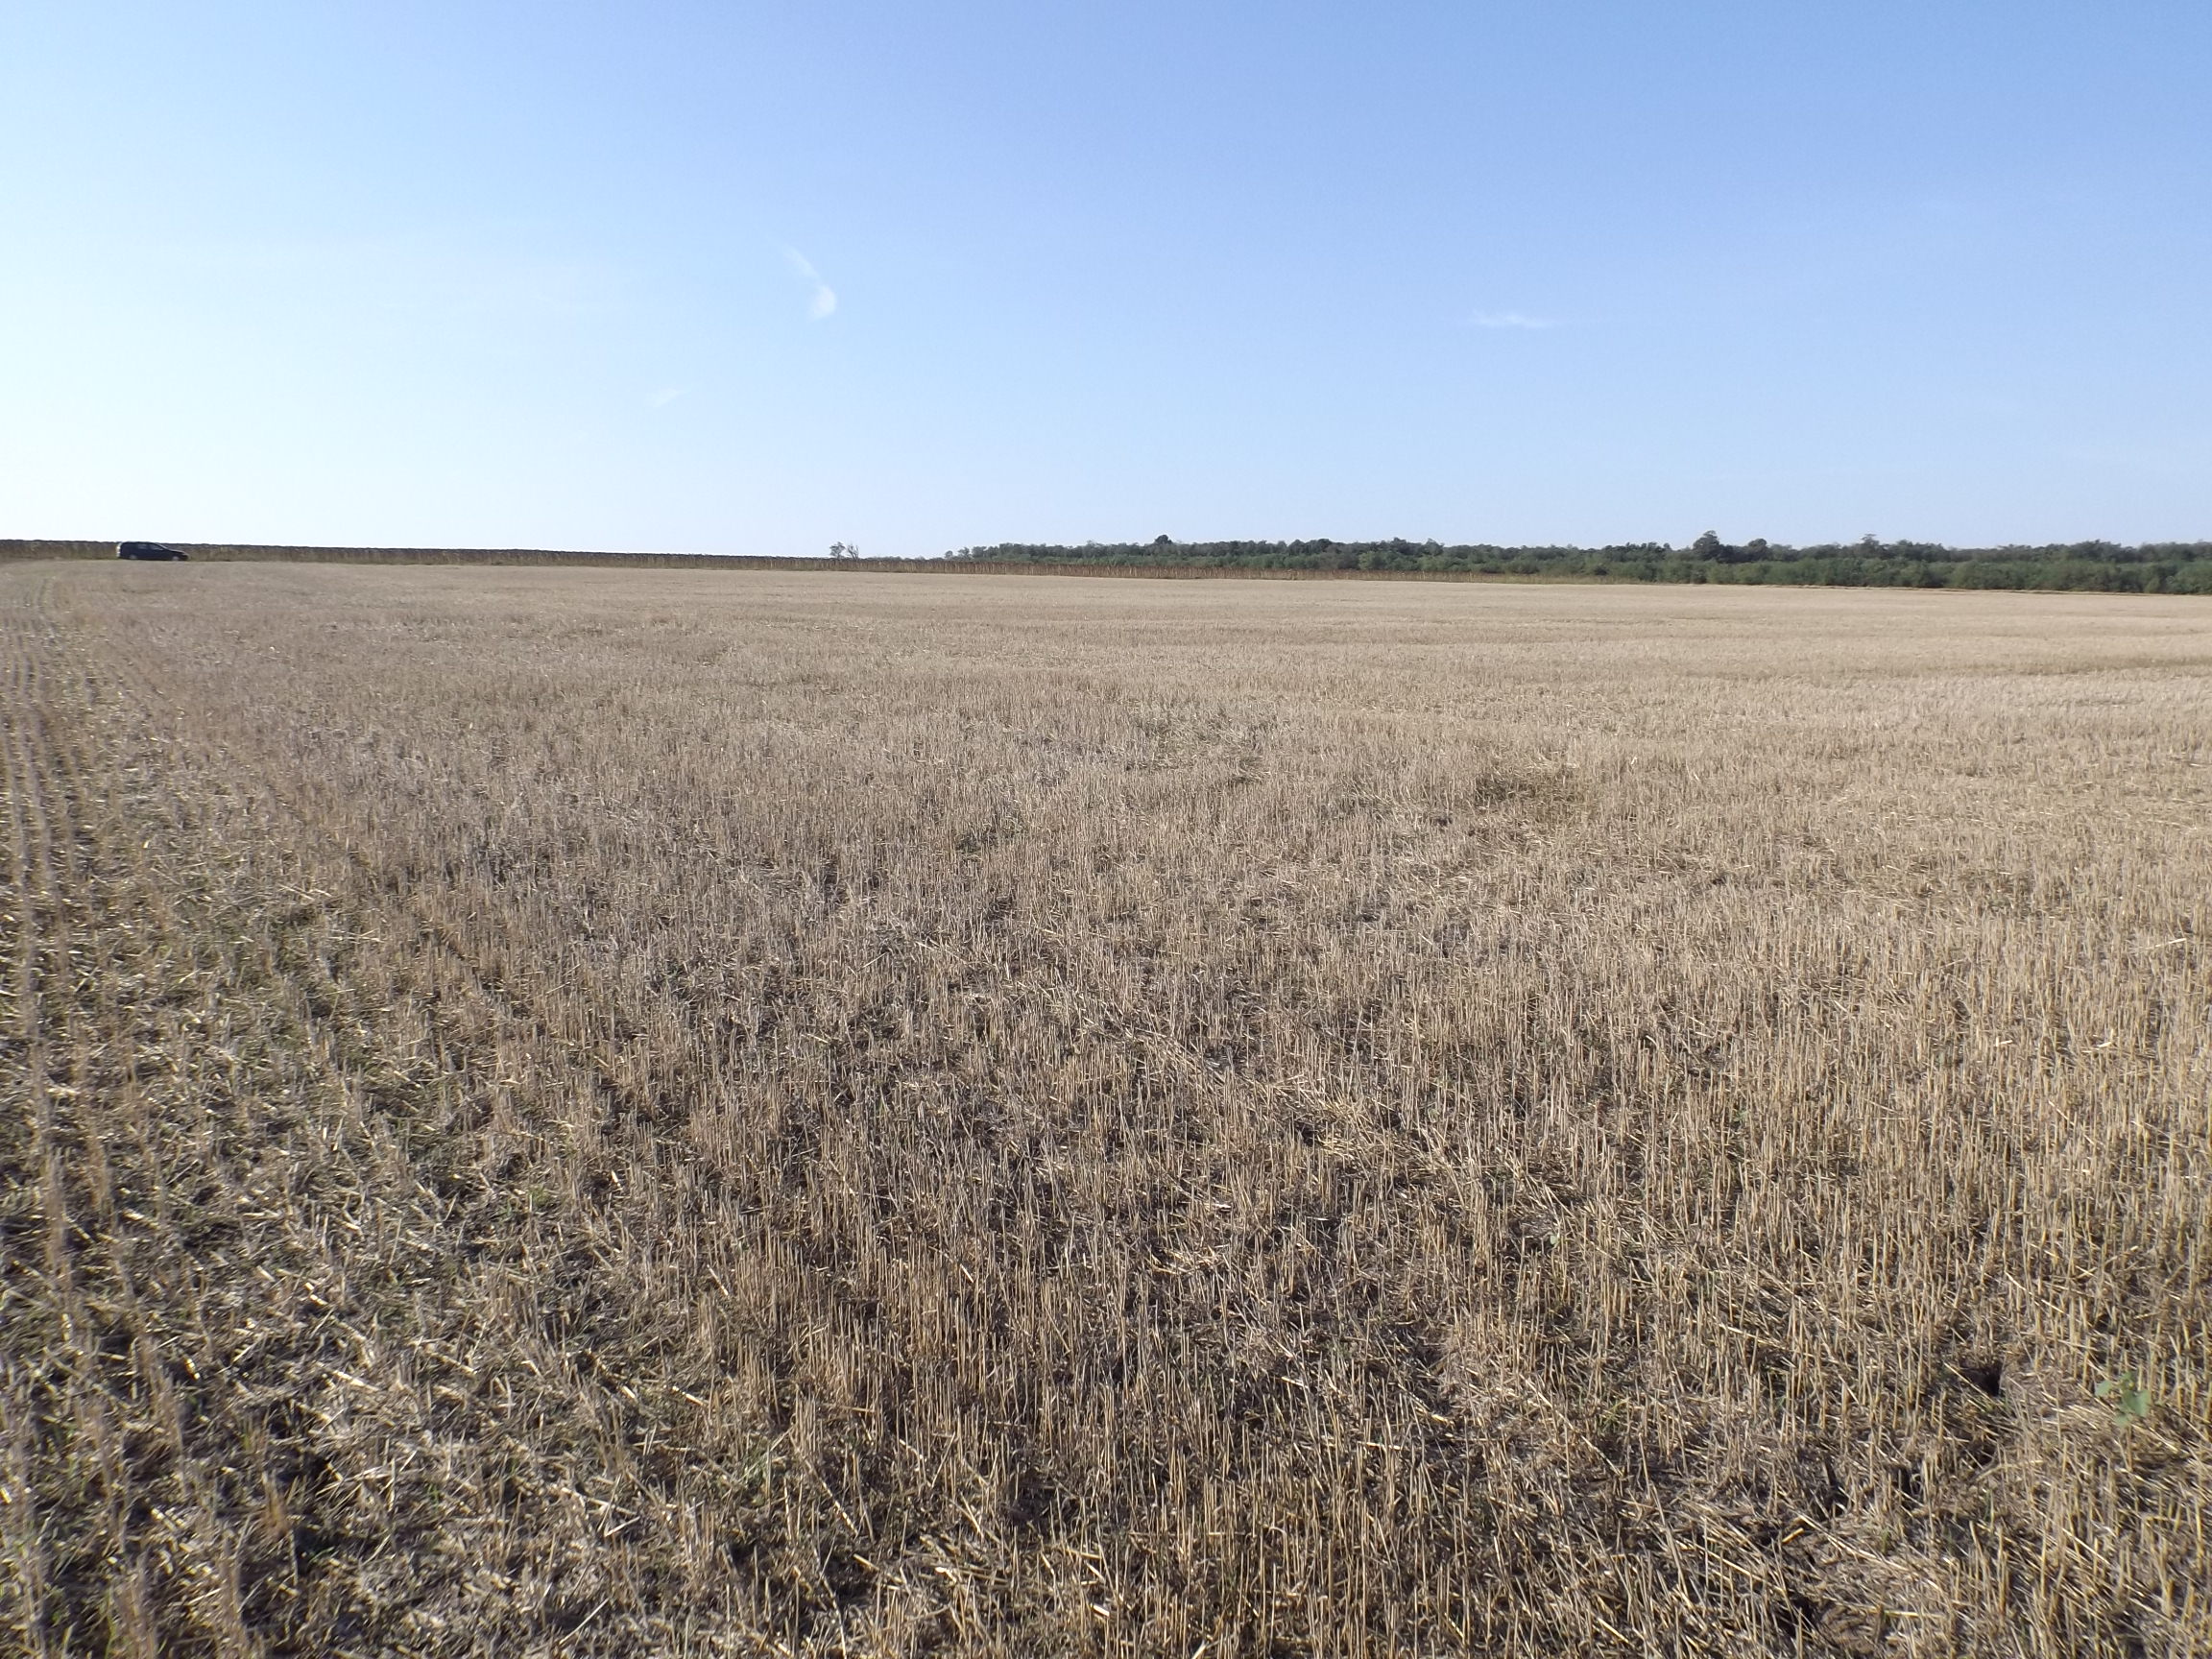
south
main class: Cropland
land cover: Common wheat
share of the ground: 25 - 50 %
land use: Agriculture (excluding fallow land and kitchen gardens)
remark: Harvested field
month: August
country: BG
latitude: 43.3973
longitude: 27.5268
